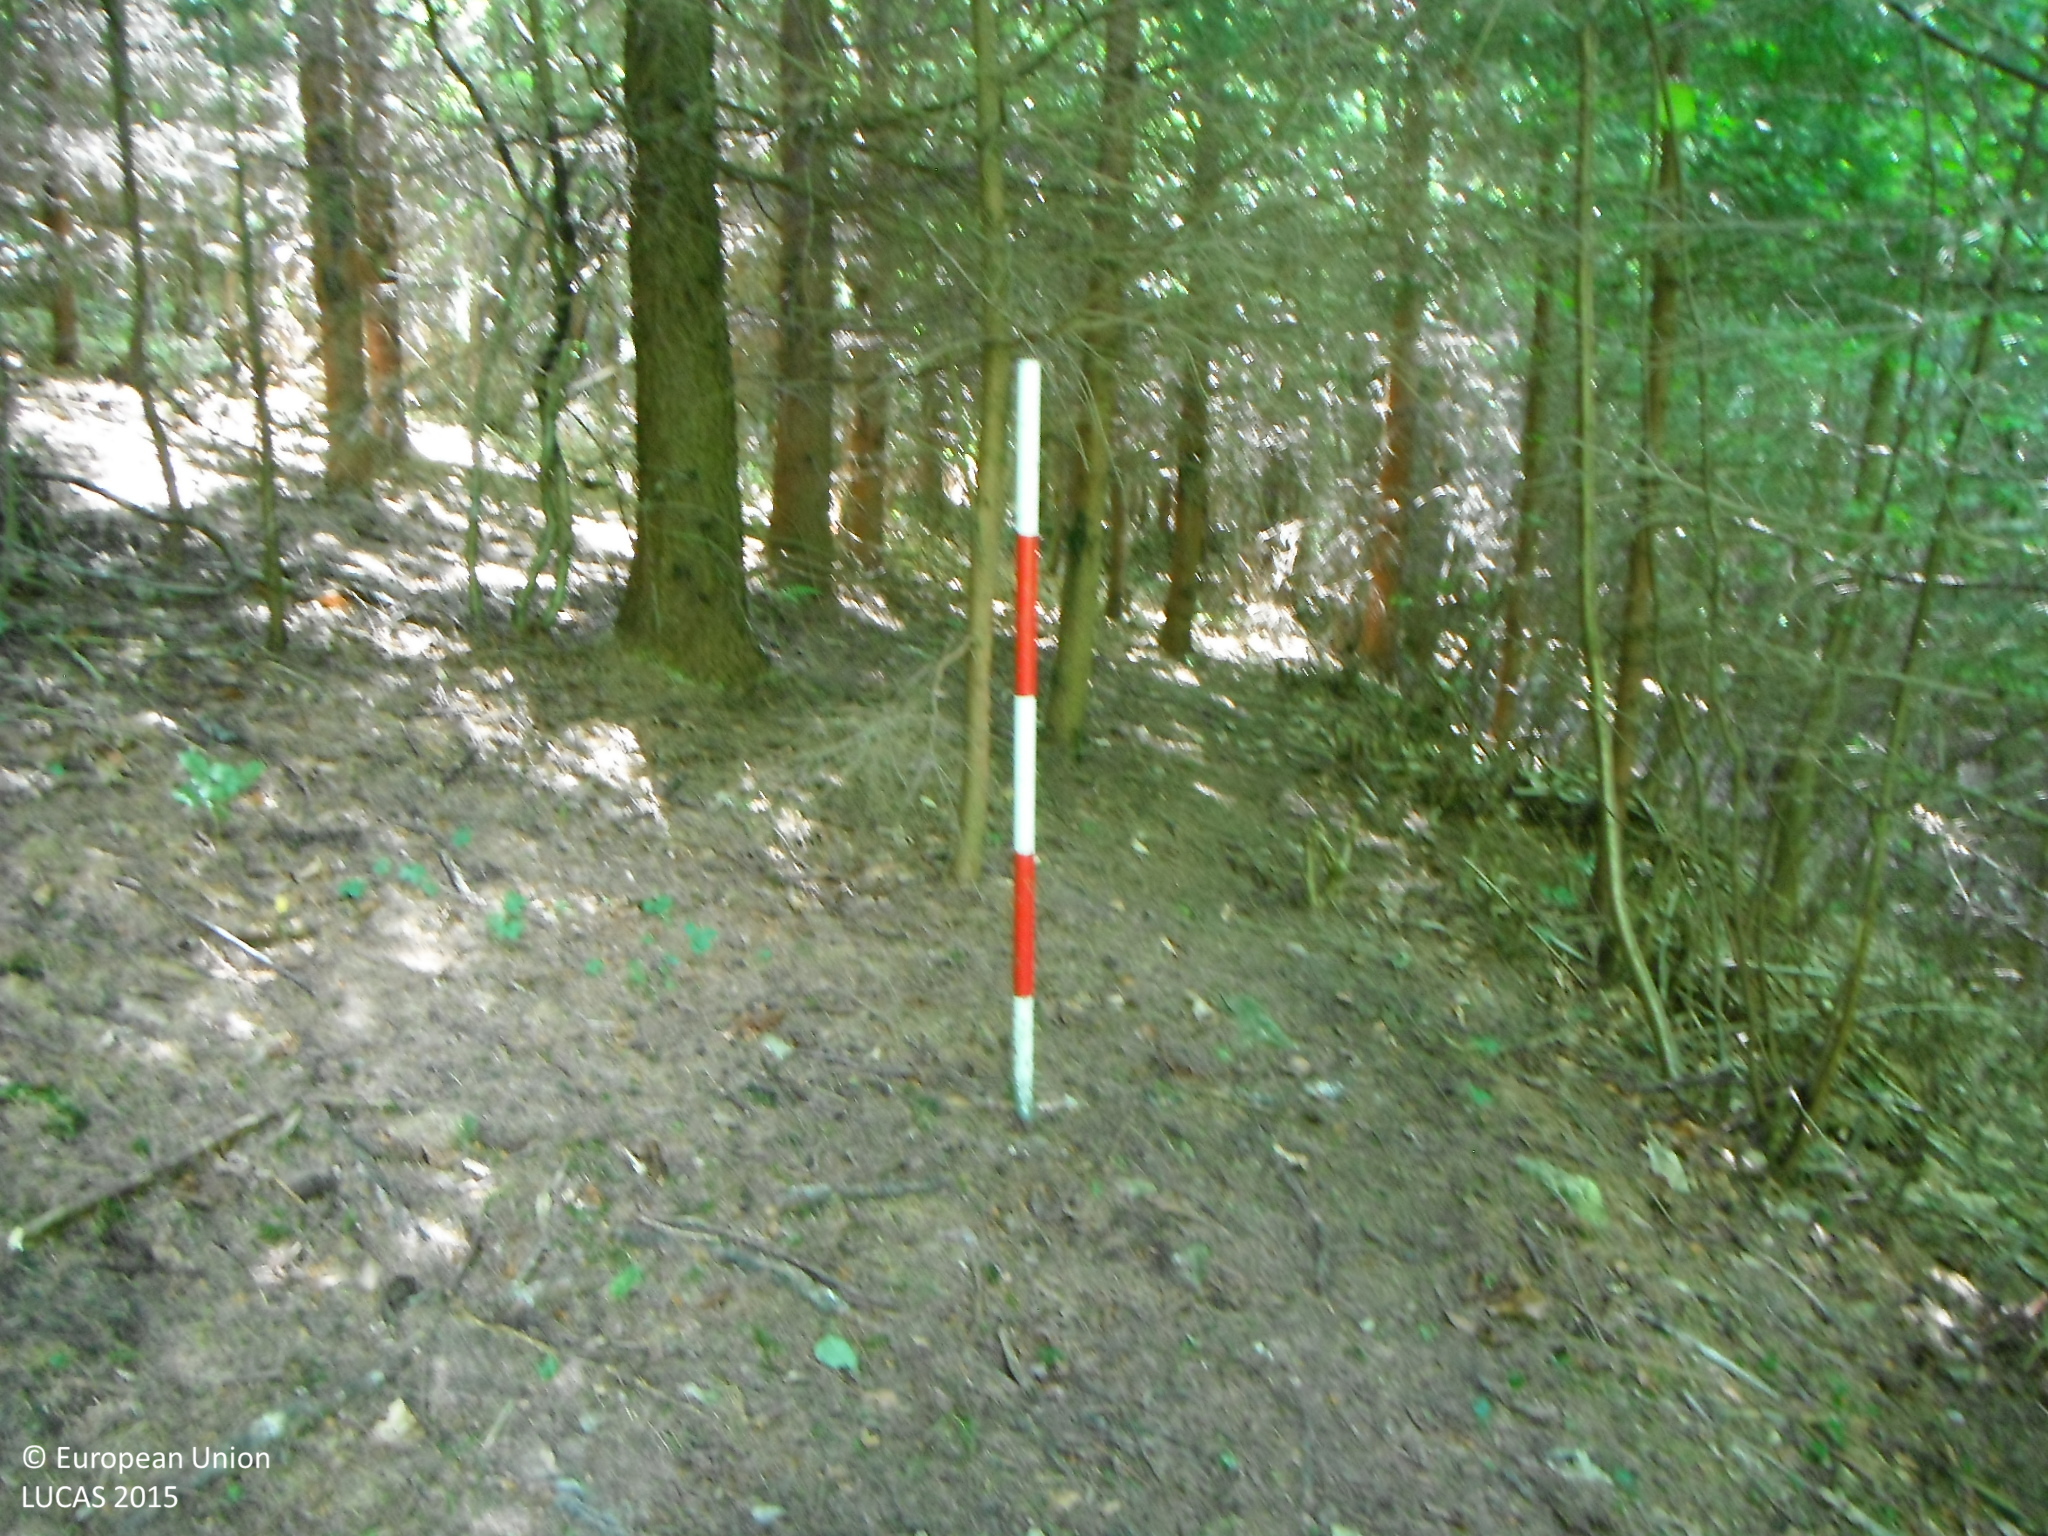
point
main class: Woodland
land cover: Spruce dominated coniferous woodland
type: alpine coniferous forest
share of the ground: > 75 %
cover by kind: coniferous forest trees 100 %
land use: Forestry
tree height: > 5 m
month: June
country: SK
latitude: 49.1222
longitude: 19.2180
